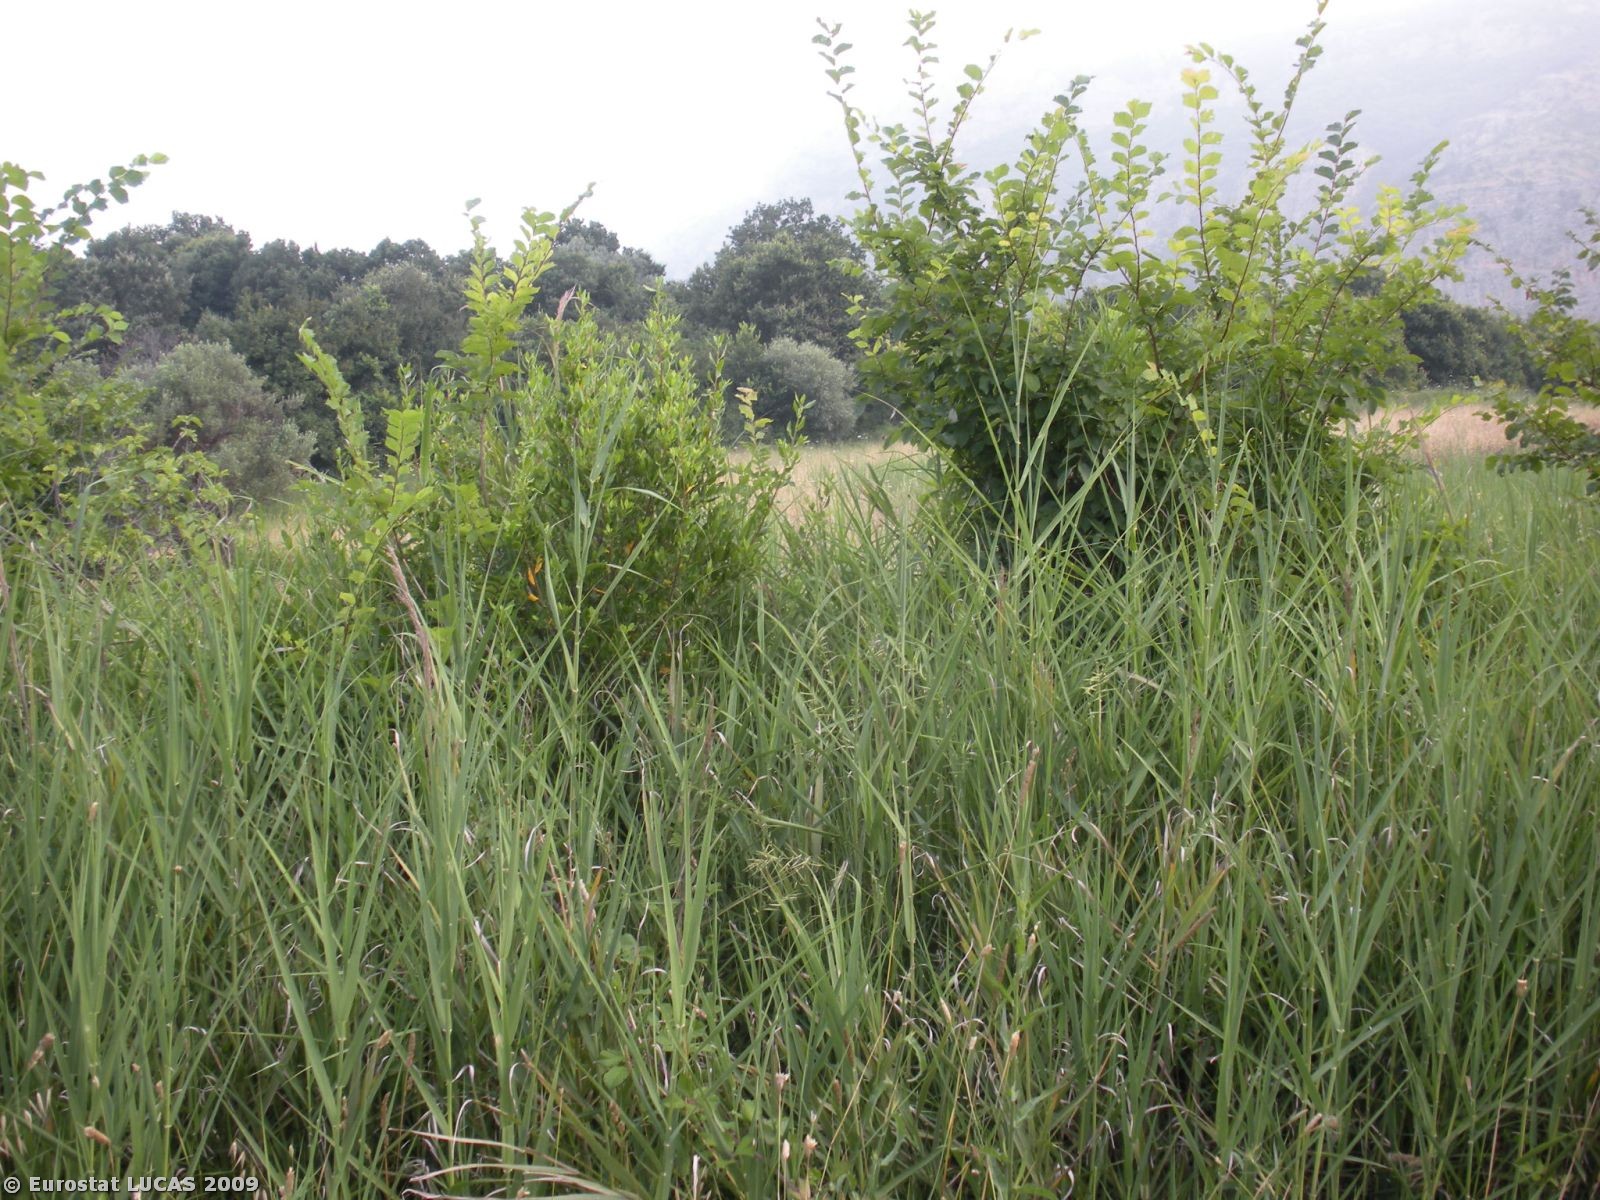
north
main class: Grassland
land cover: Grassland with sparse tree/shrub cover
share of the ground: > 75 %
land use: Fallow land
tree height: < 5 m
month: July
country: IT
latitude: 40.4269
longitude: 15.0584
